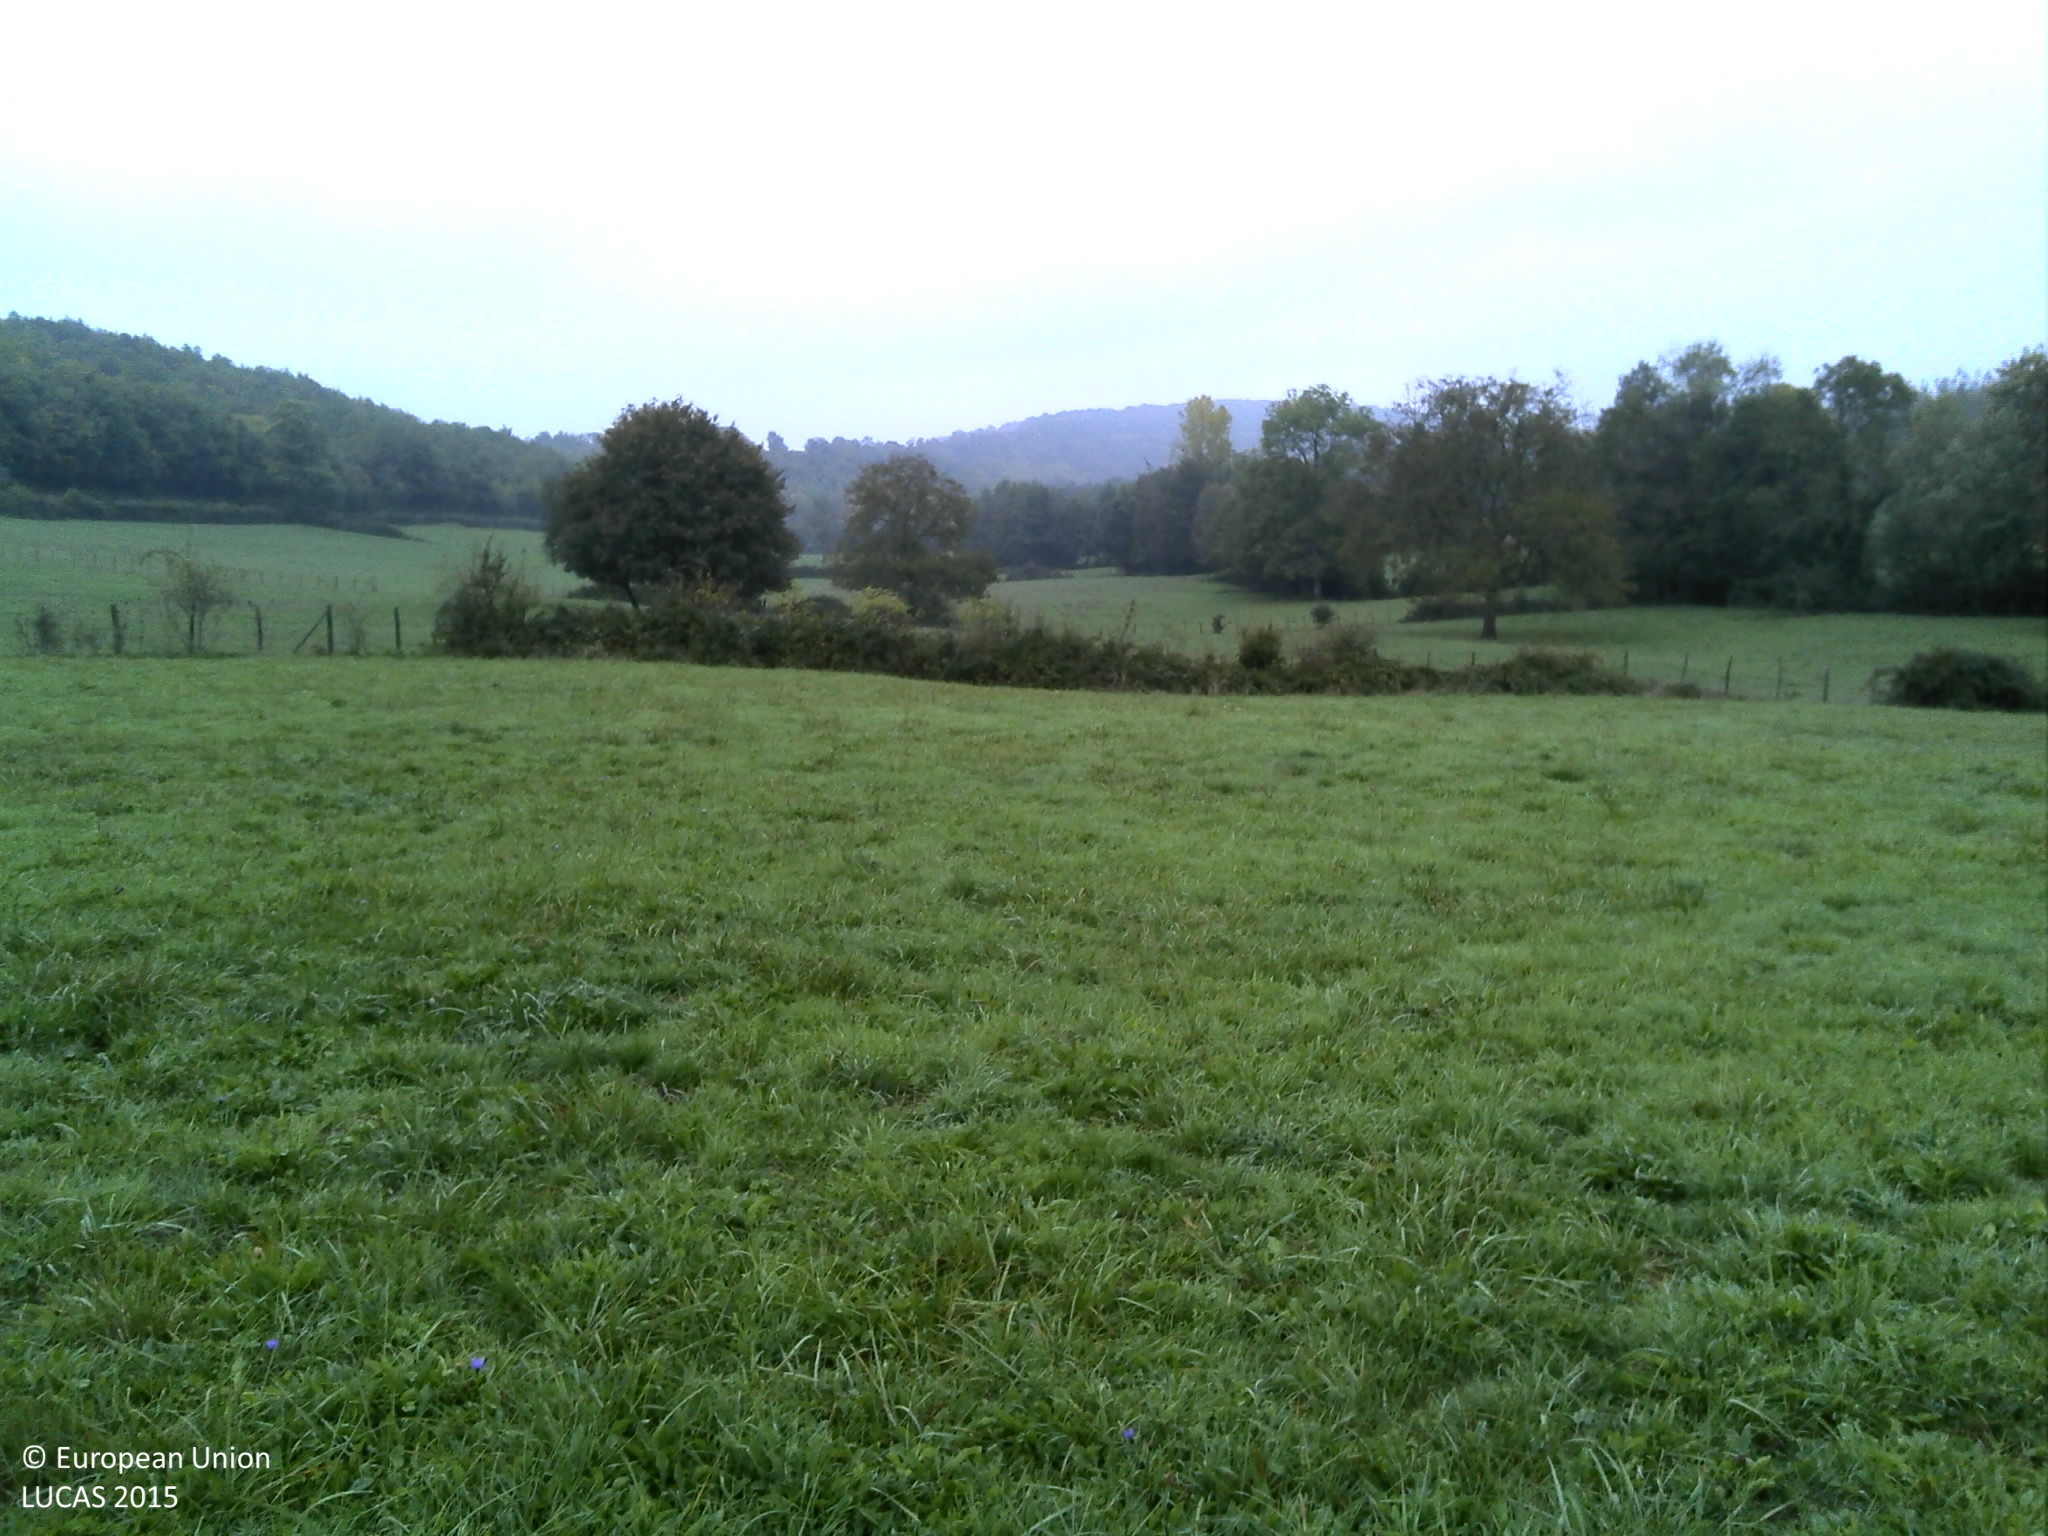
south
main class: Grassland
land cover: Grassland without tree/shrub cover
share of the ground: > 75 %
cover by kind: herbaceous plants 100 %
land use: Agriculture (excluding fallow land and kitchen gardens)
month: October
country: FR
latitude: 46.4238
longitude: 4.8102
